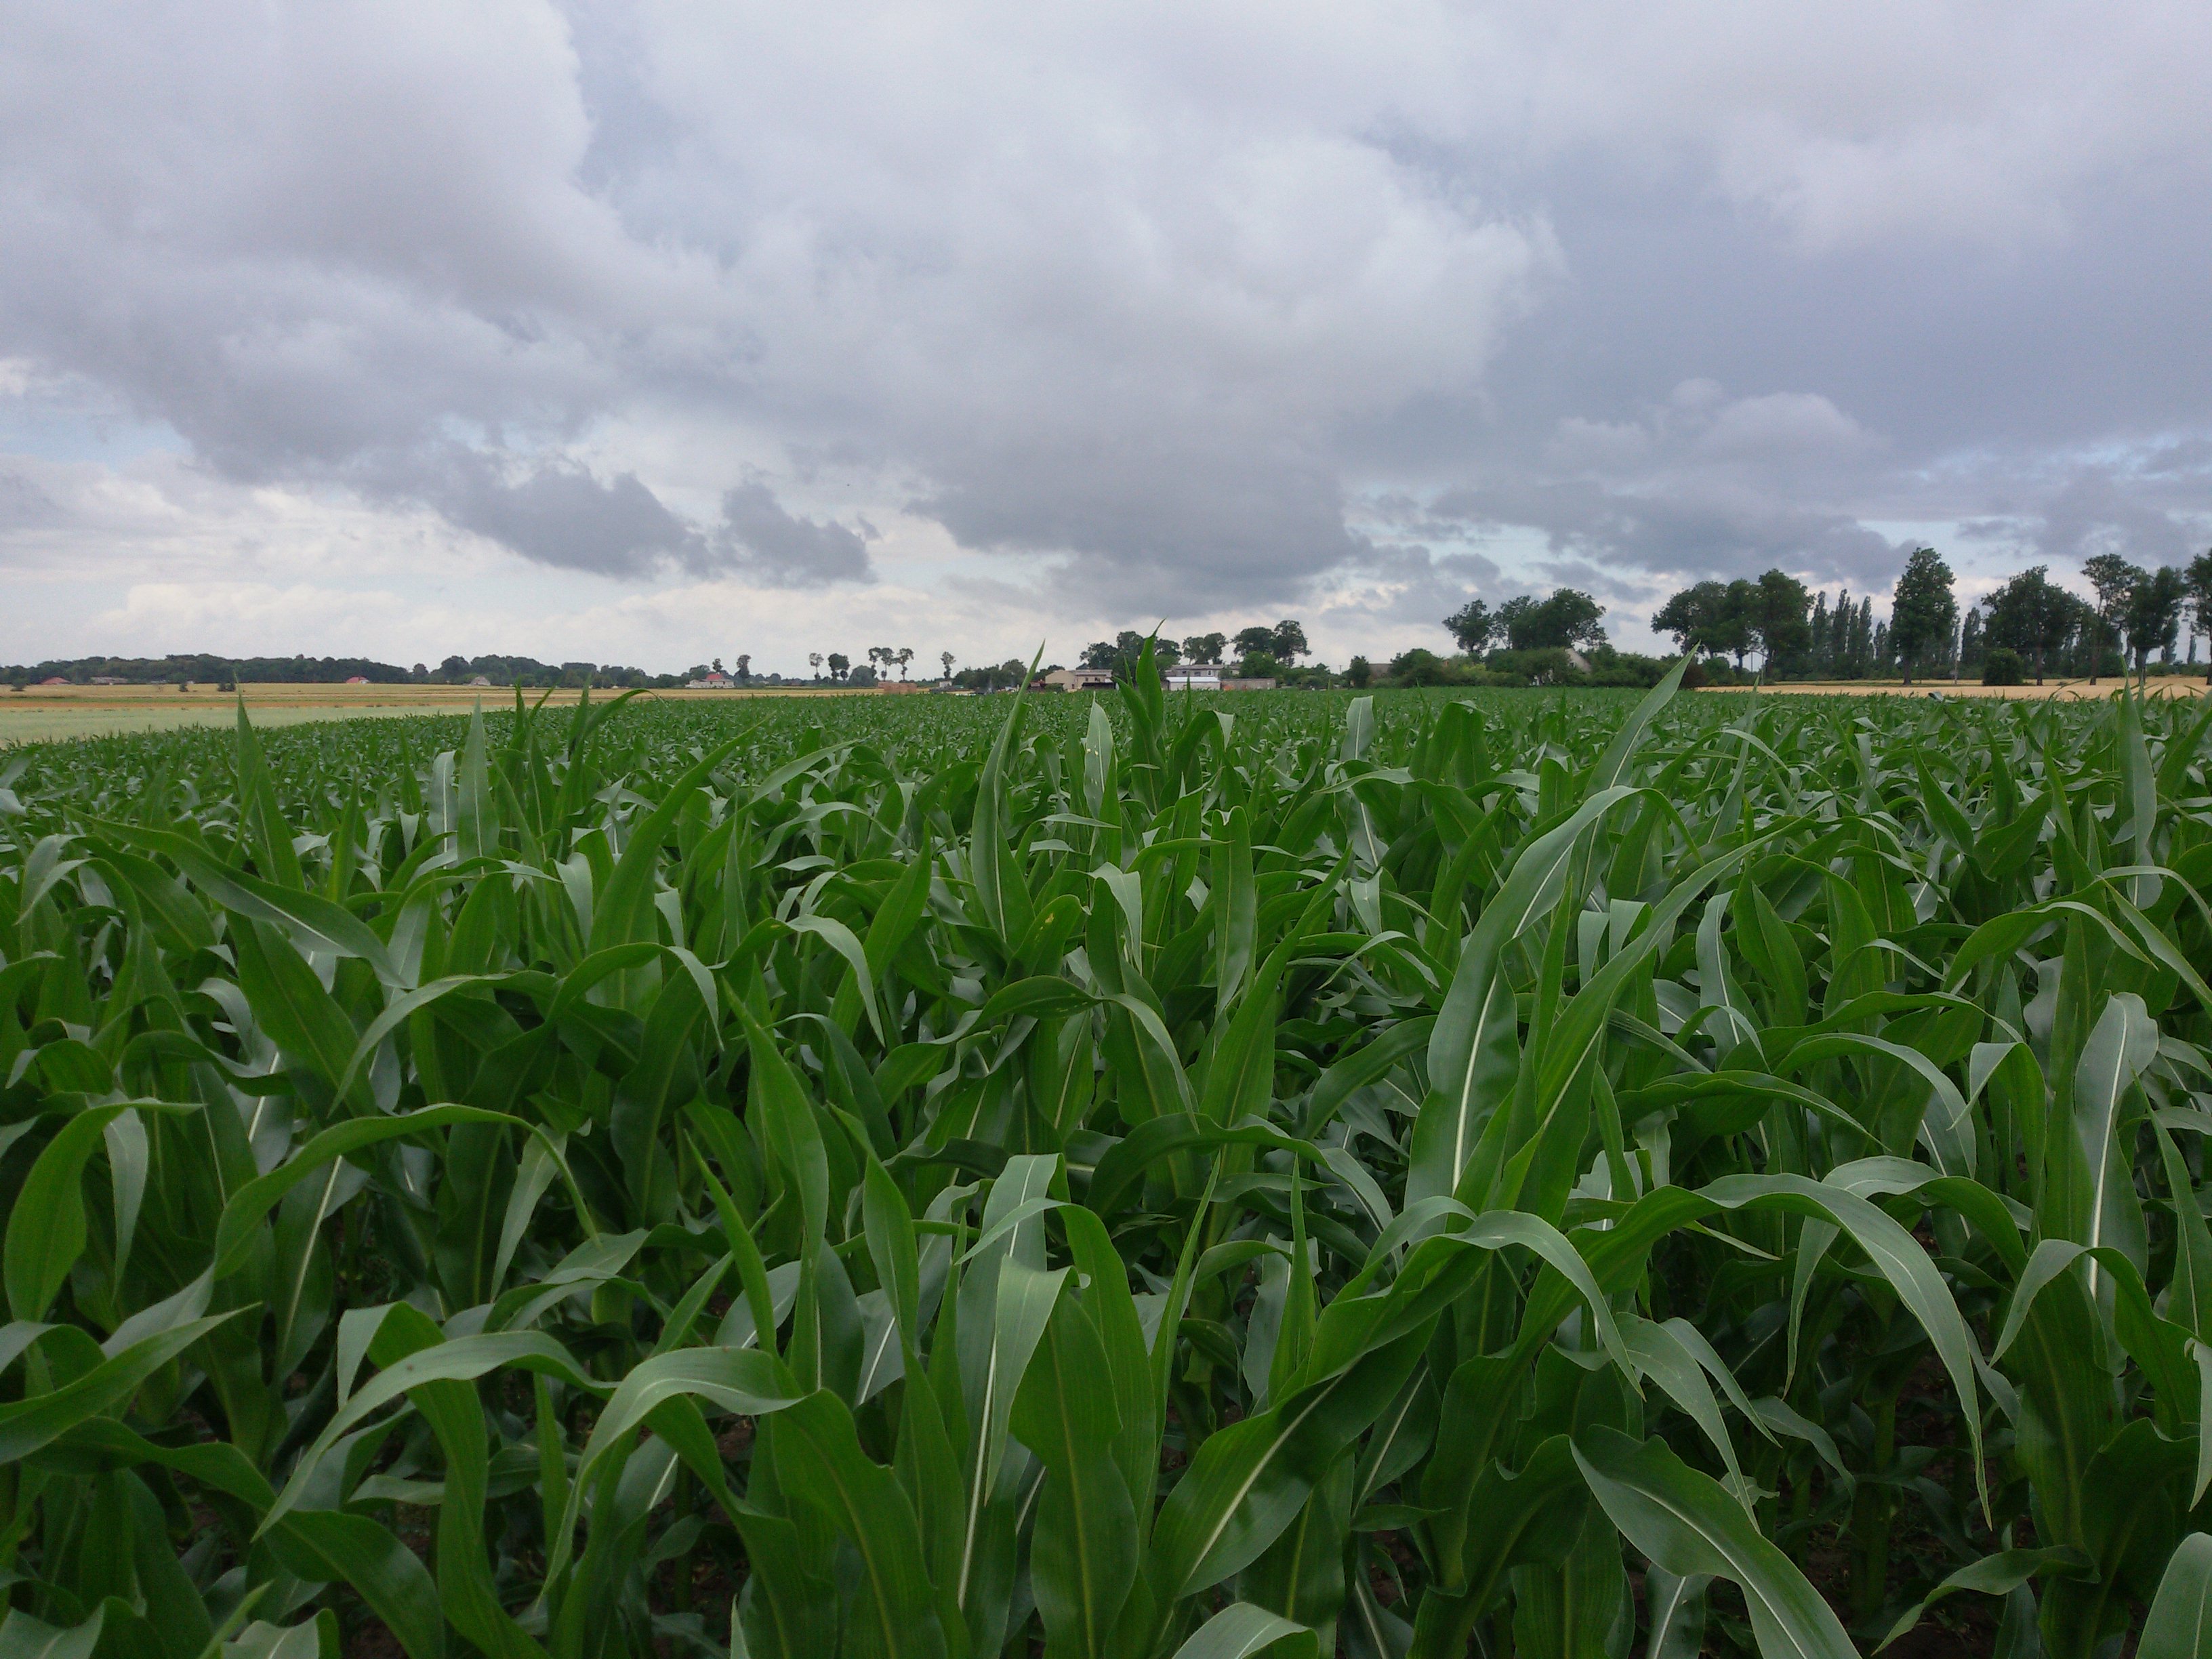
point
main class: Cropland
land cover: Maize
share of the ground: > 75 %
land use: Agriculture (excluding fallow land and kitchen gardens)
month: July
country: PL
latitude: 52.8540
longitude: 17.6313
